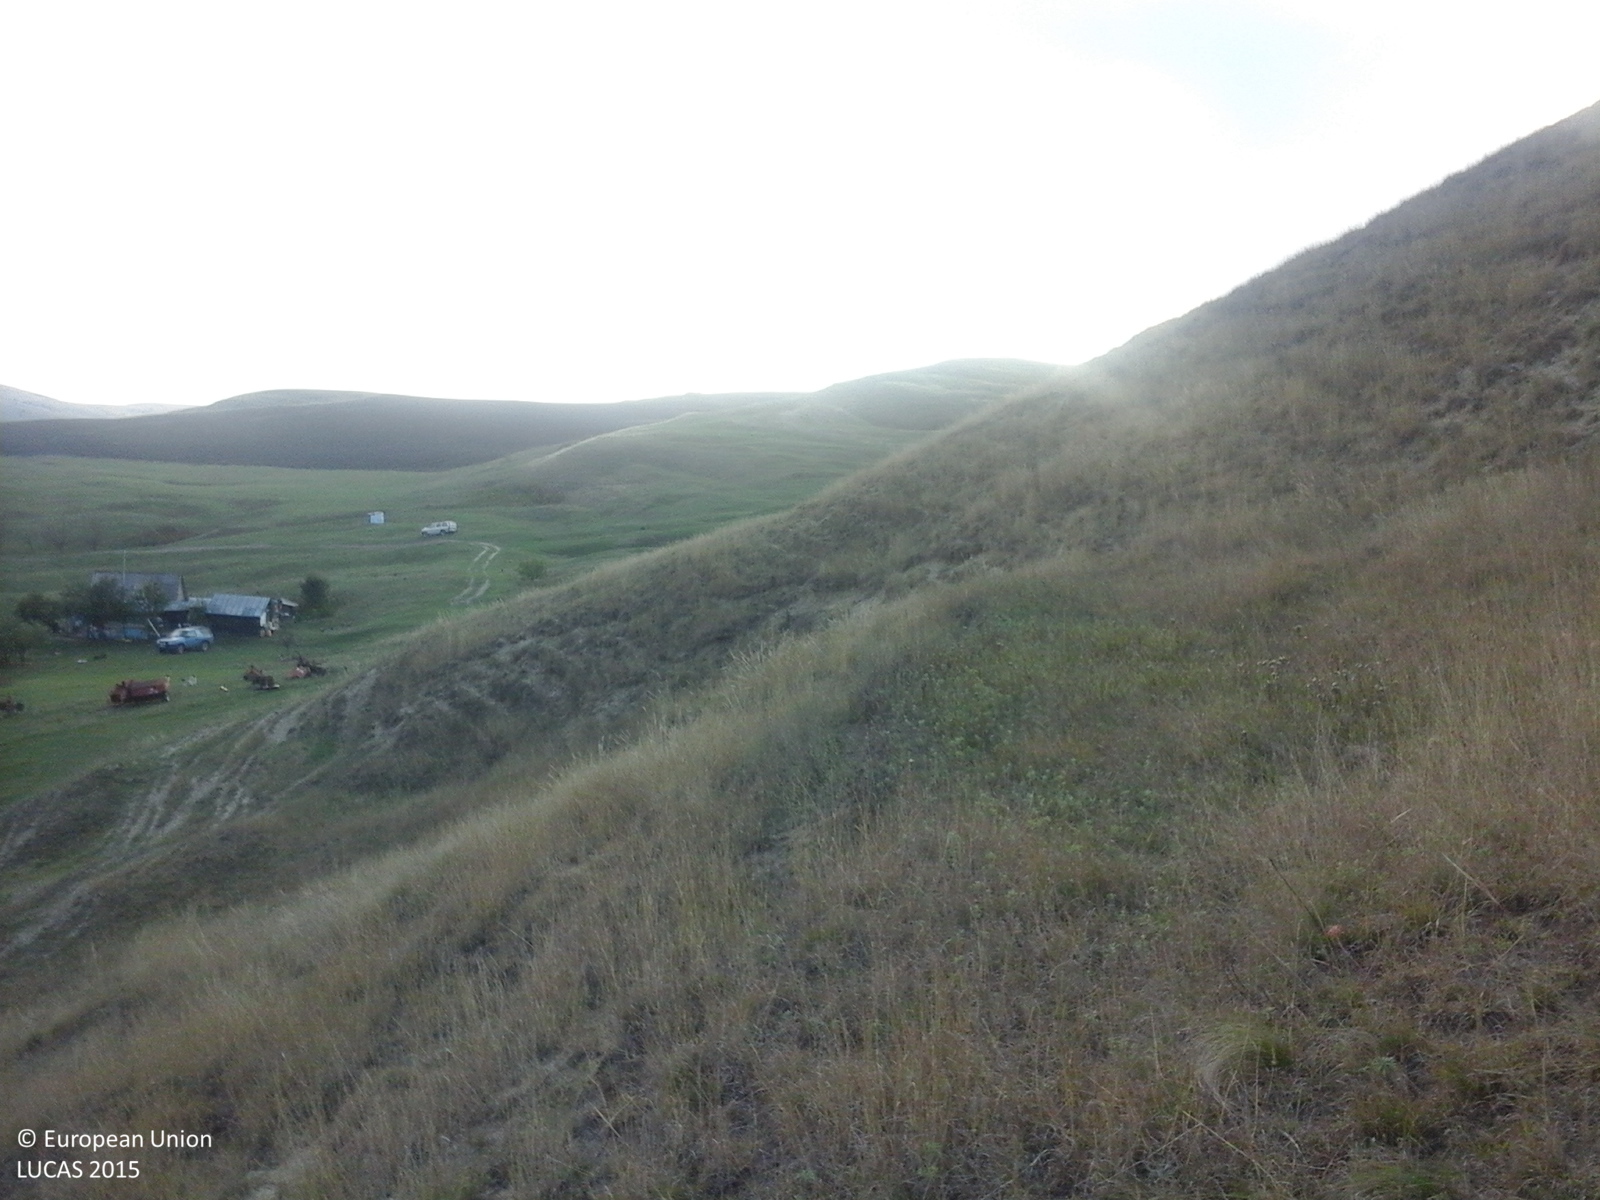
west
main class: Grassland
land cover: Grassland without tree/shrub cover
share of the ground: > 75 %
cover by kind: herbaceous plants 100 %
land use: Agriculture (excluding fallow land and kitchen gardens)
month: October
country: RO
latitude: 46.2582
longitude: 23.9157
